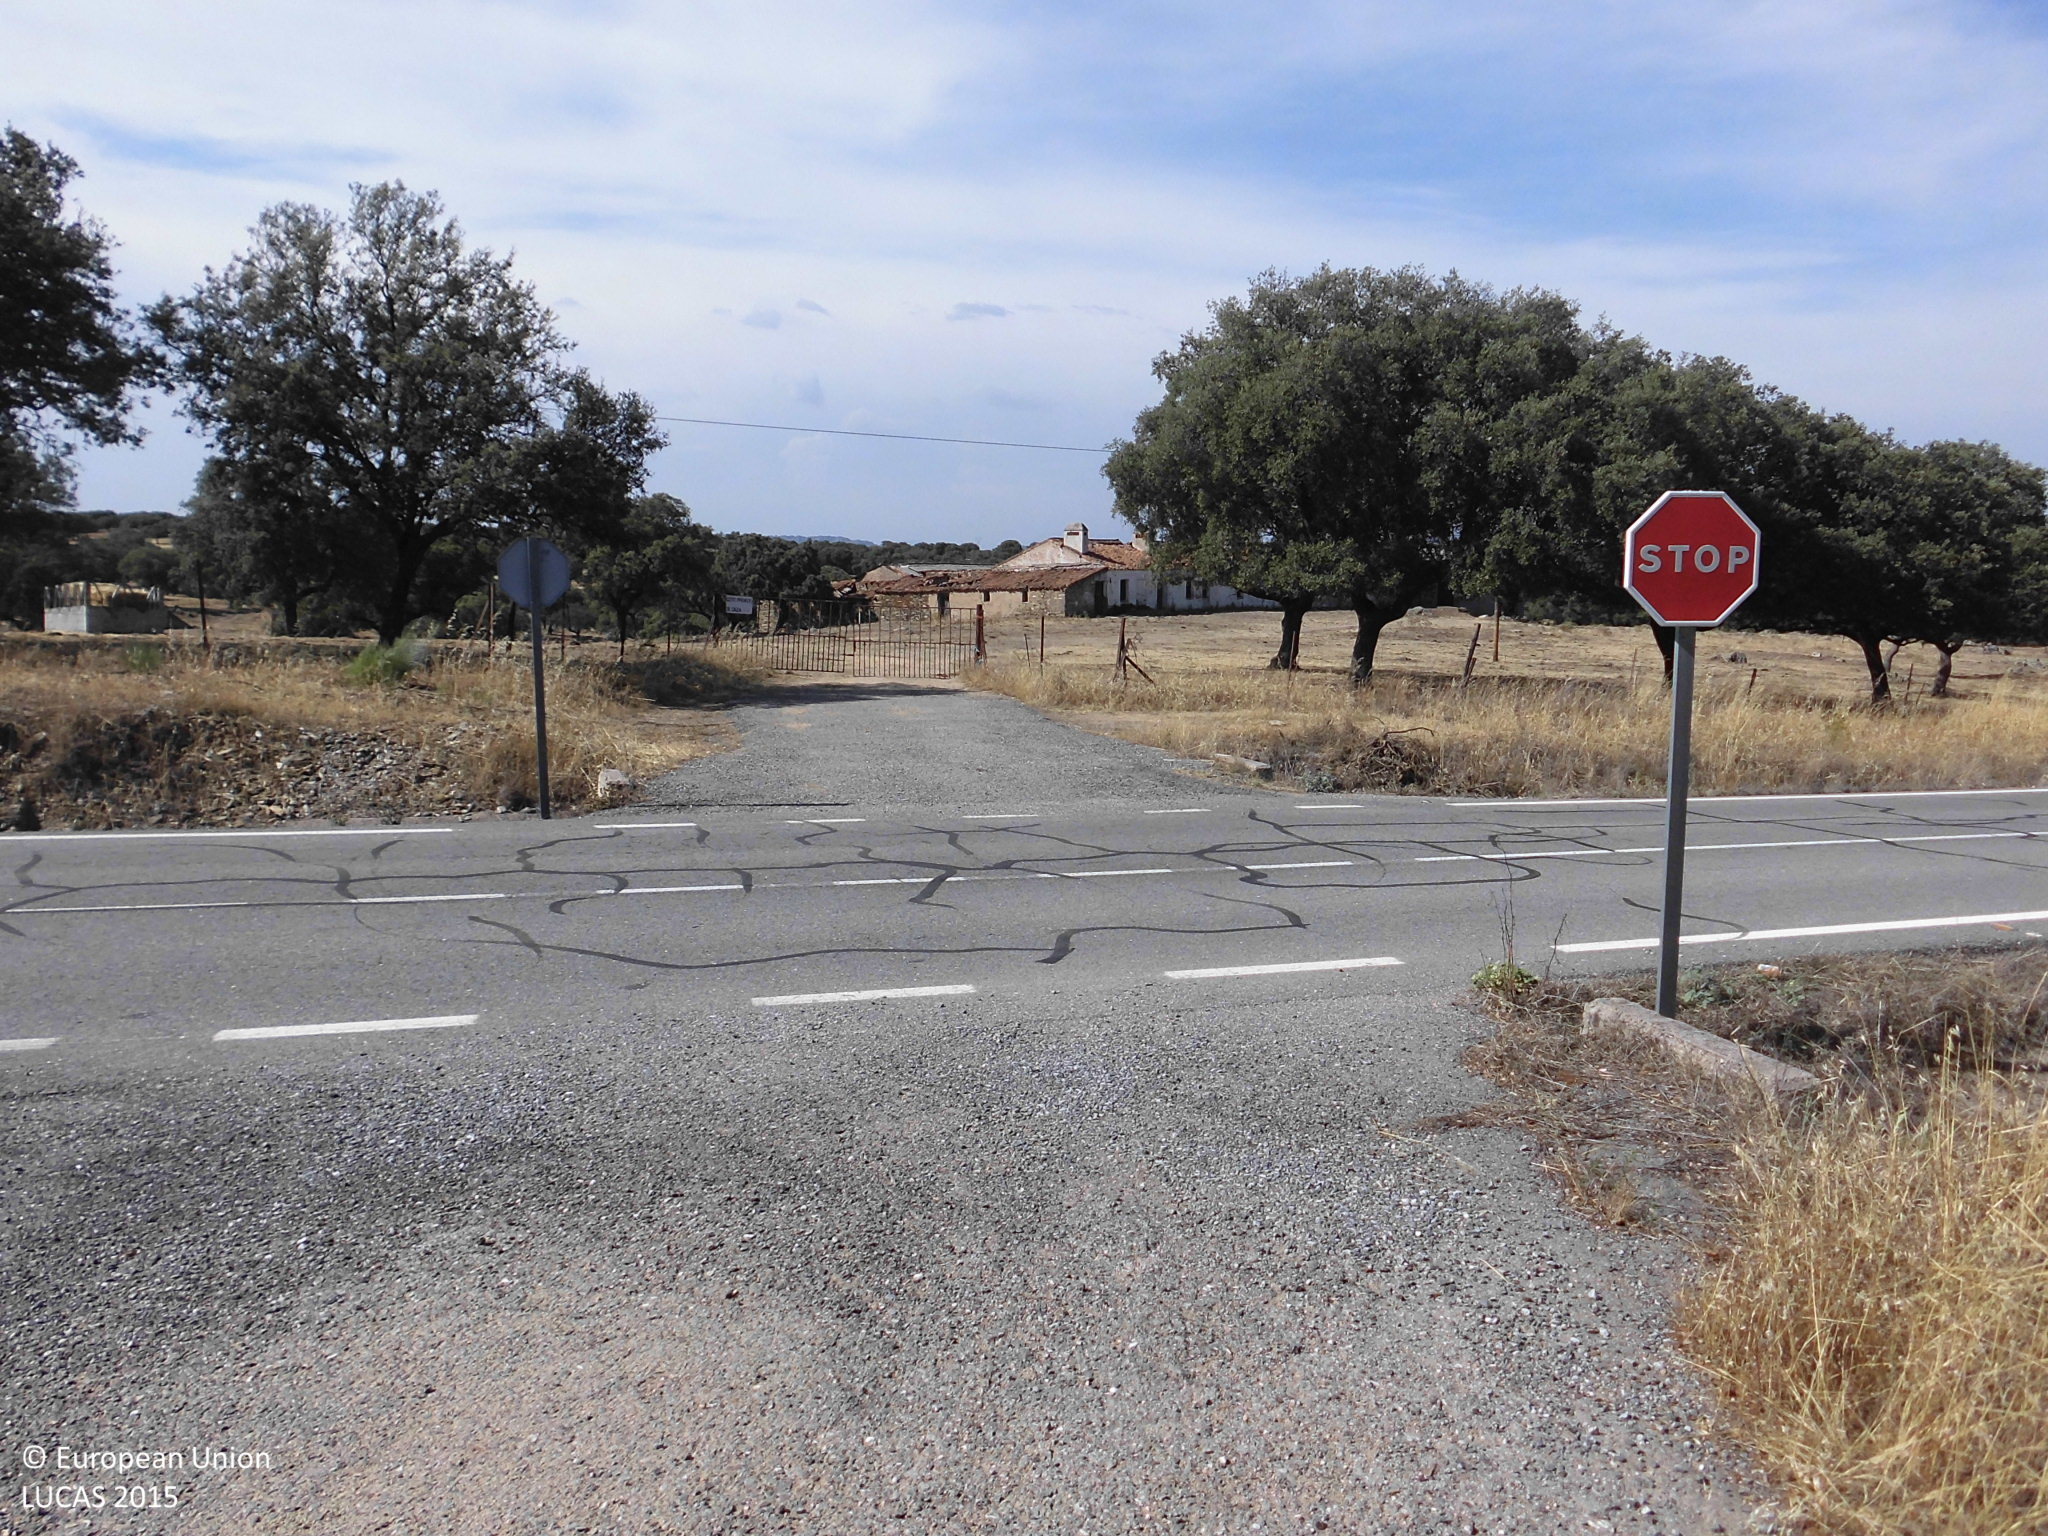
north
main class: Woodland
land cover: Broadleaved woodland
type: broadleaved evergreen forest
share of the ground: 25 - 50 %
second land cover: Grassland without tree/shrub cover
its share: > 75 %
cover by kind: herbaceous plants 70 %, broadleaved forest trees 30 %
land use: Forestry
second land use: Agriculture (excluding fallow land and kitchen gardens)
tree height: > 5 m
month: June
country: ES
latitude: 39.7434
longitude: -6.0656
